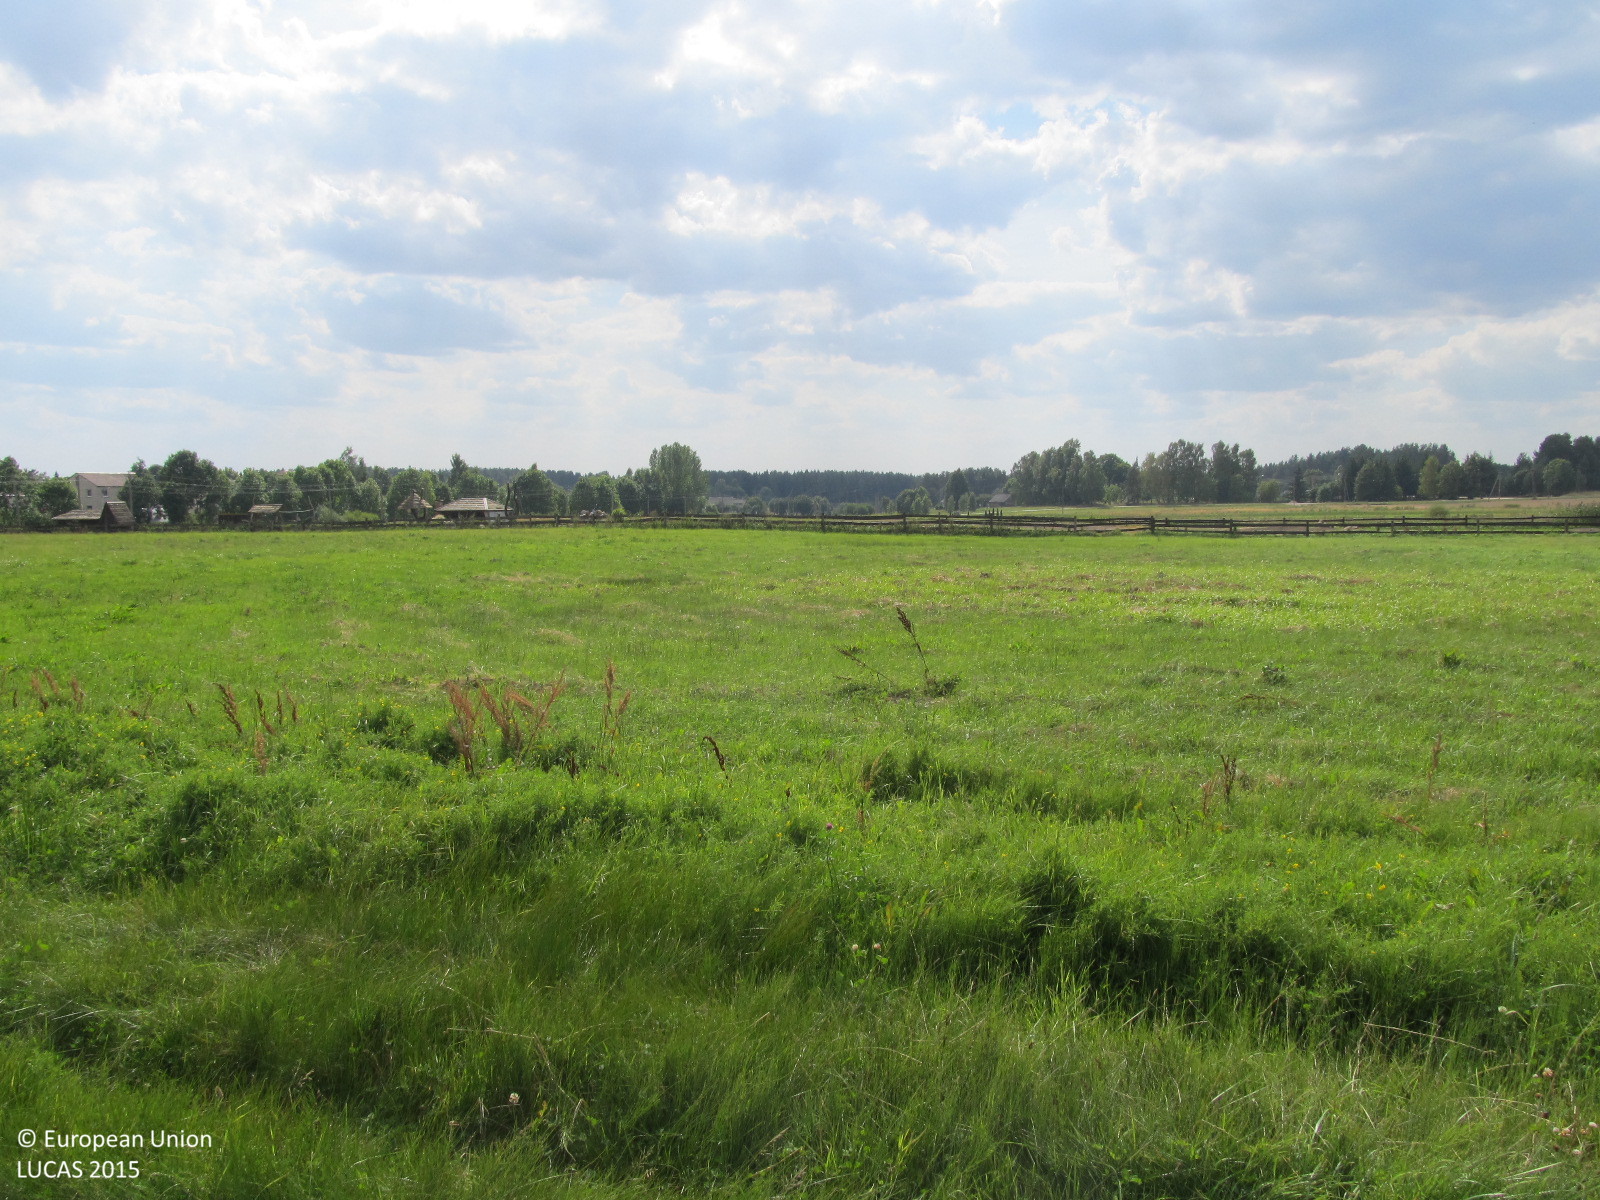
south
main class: Grassland
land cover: Grassland without tree/shrub cover
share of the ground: > 75 %
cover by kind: herbaceous plants 100 %
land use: Agriculture (excluding fallow land and kitchen gardens)
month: August
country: LT
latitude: 55.8005
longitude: 23.1362
